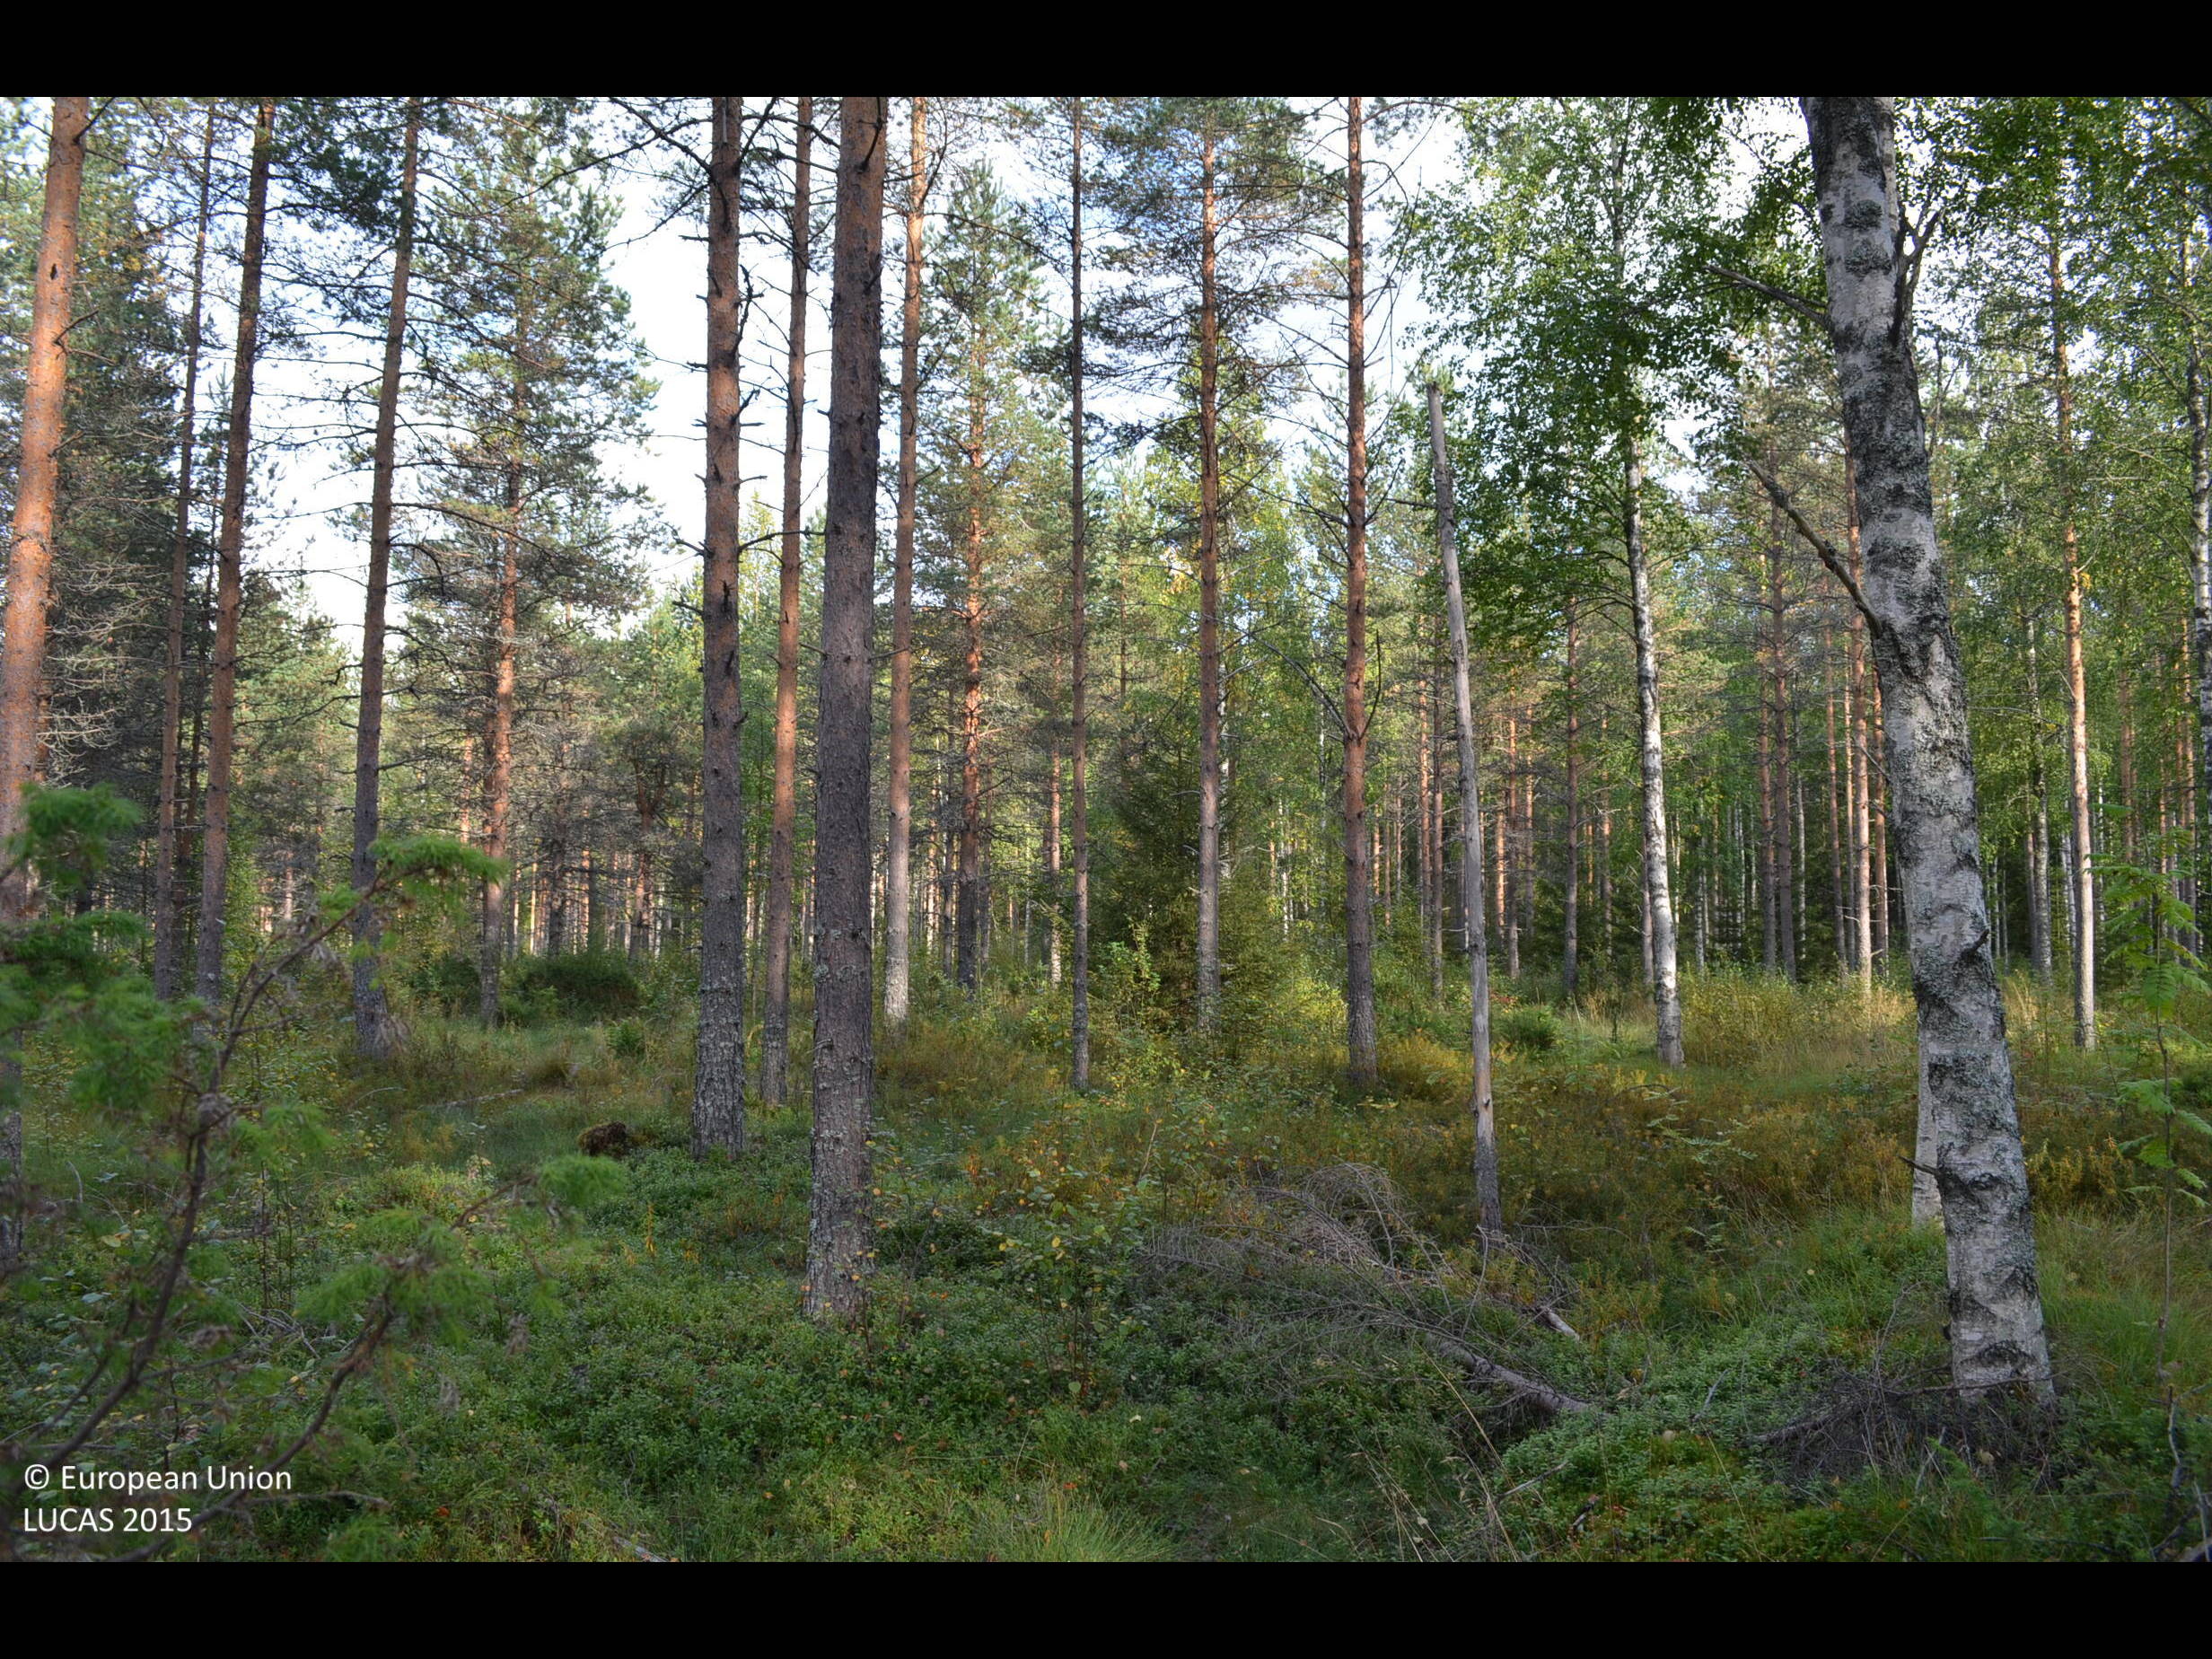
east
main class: Woodland
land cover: Pine dominated mixed woodland
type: boreal forest
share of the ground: 50 - 75 %
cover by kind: coniferous forest trees 40 %, broadleaved forest trees 25 %, shrubs 25 %, herbaceous plants 5 %
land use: Forestry
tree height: > 5 m
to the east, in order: Pine dominated mixed woodland; Ditches and canals; Pine dominated mixed woodland; Ditches and canals; Pine dominated mixed woodland; Ditches and canals; Pine dominated mixed woodland; Ditches and canals; Other mixed woodland; Pine dominated coniferous woodland; Ditches and canals; Abandoned hedges; Tracks; Shruby margins; Ditches and canals; Other coniferous woodland
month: August
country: FI
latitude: 62.6972
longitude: 24.4898
